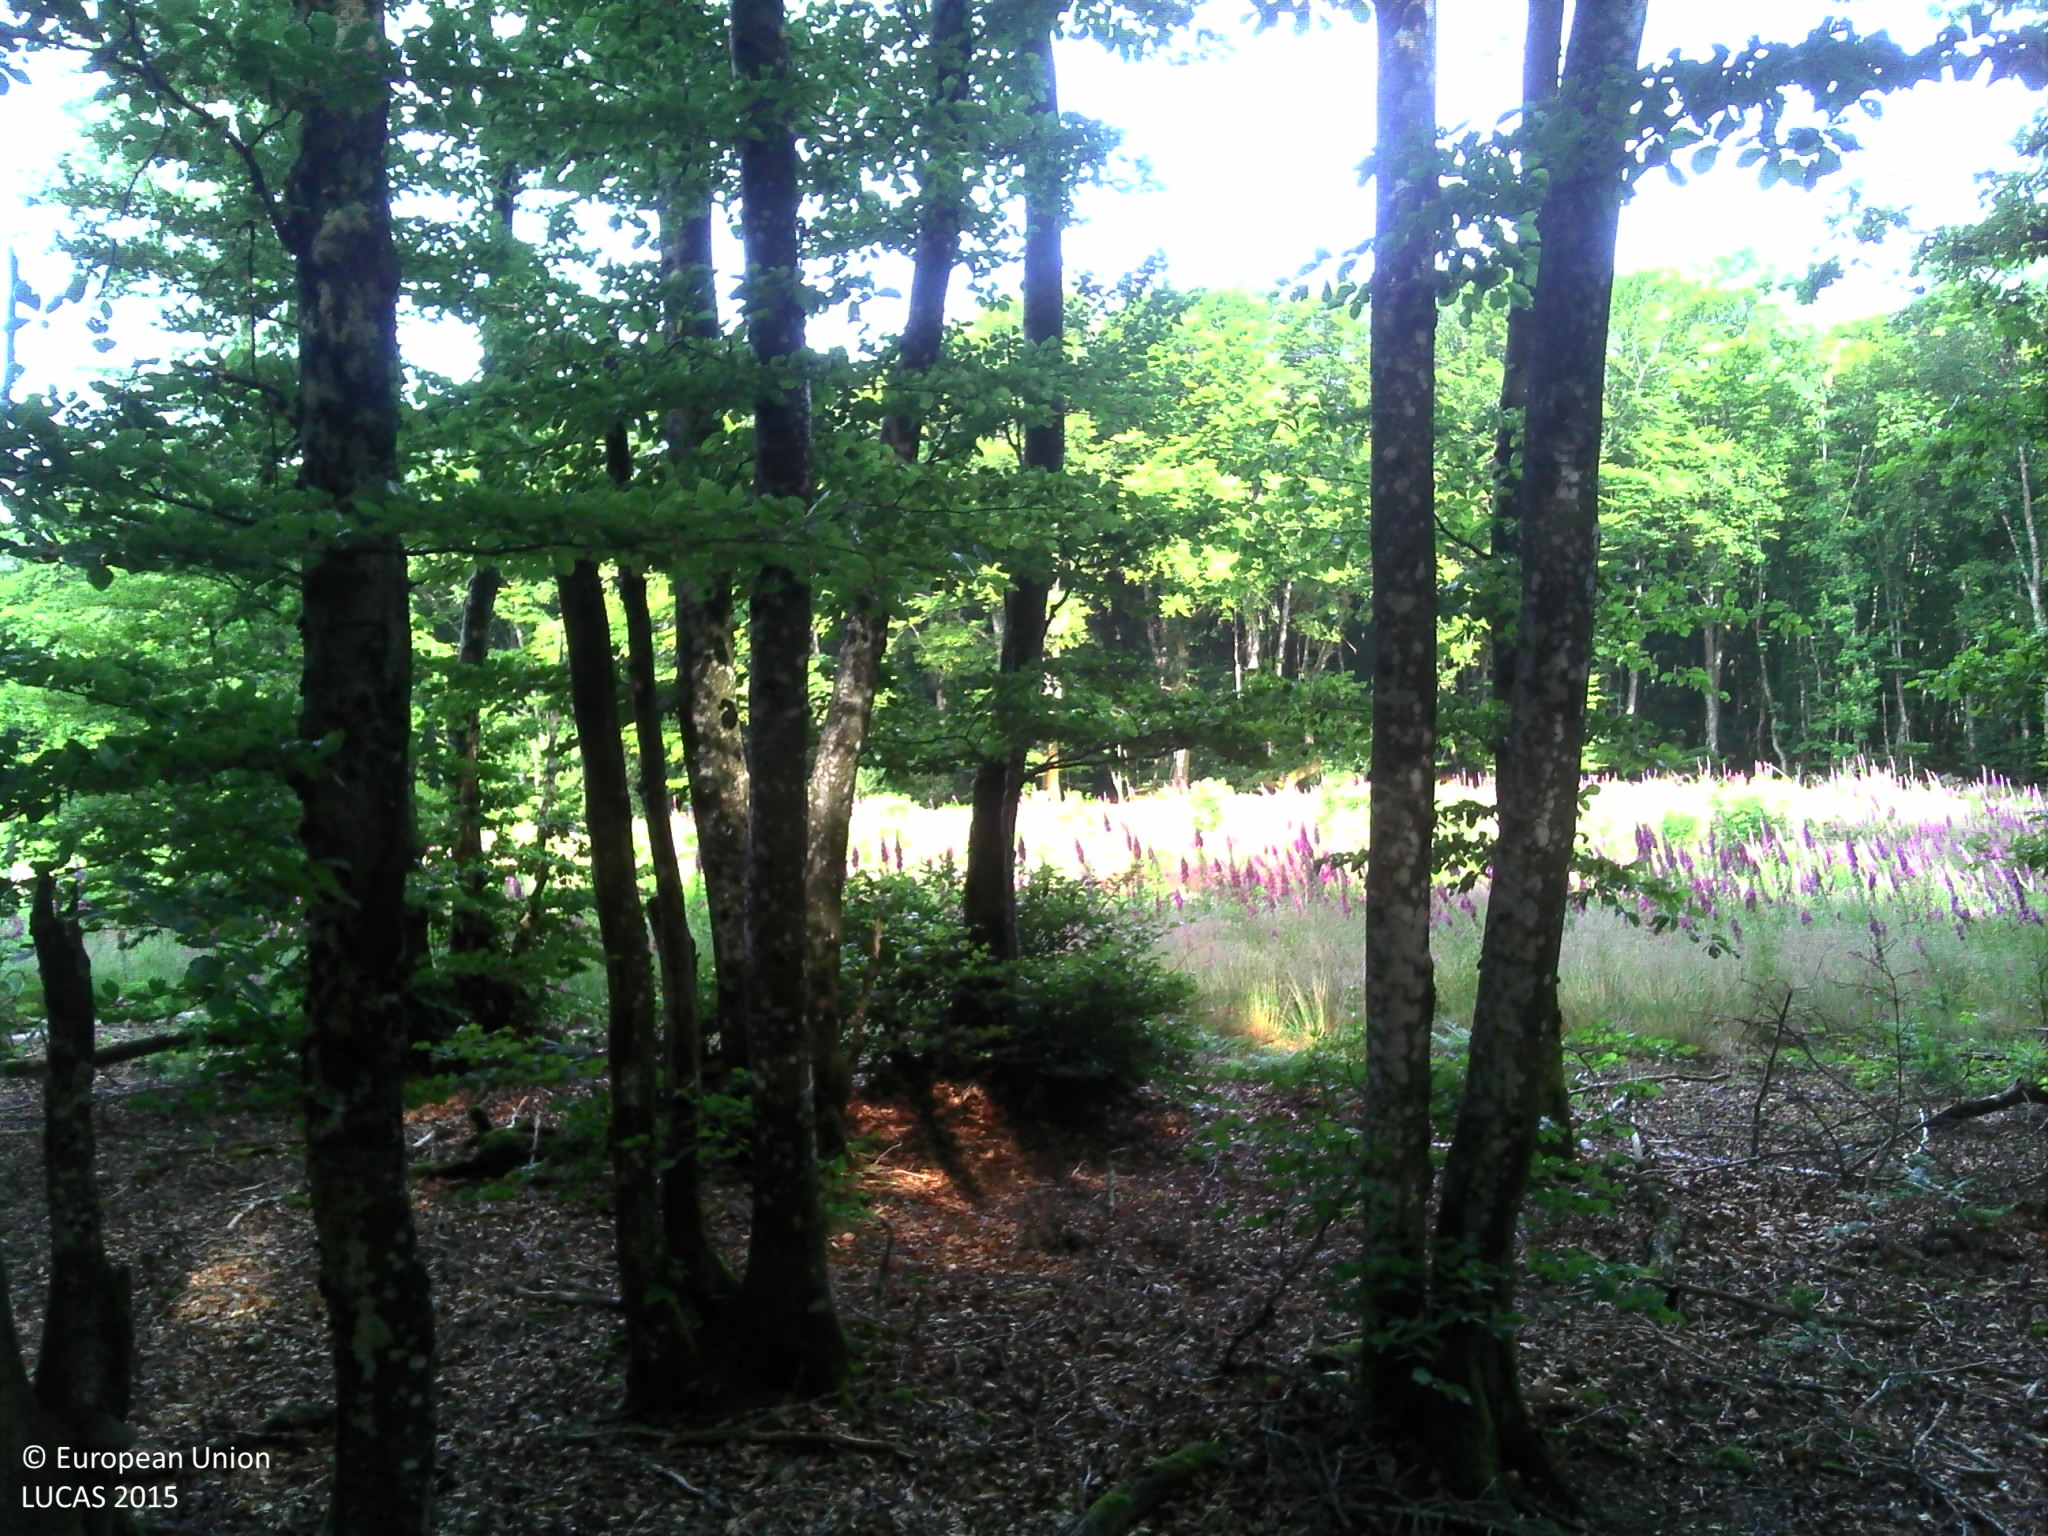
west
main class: Woodland
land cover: Spruce dominated mixed woodland
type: hemiboreal forest and nemoral coniferous forest and mixed broadleaved-coniferous forest
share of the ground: > 75 %
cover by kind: broadleaved forest trees 65 %, coniferous forest trees 25 %, herbaceous plants 5 %, lichens and mosses 5 %
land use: Forestry
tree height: > 5 m
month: June
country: FR
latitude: 46.9588
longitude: 3.9936
